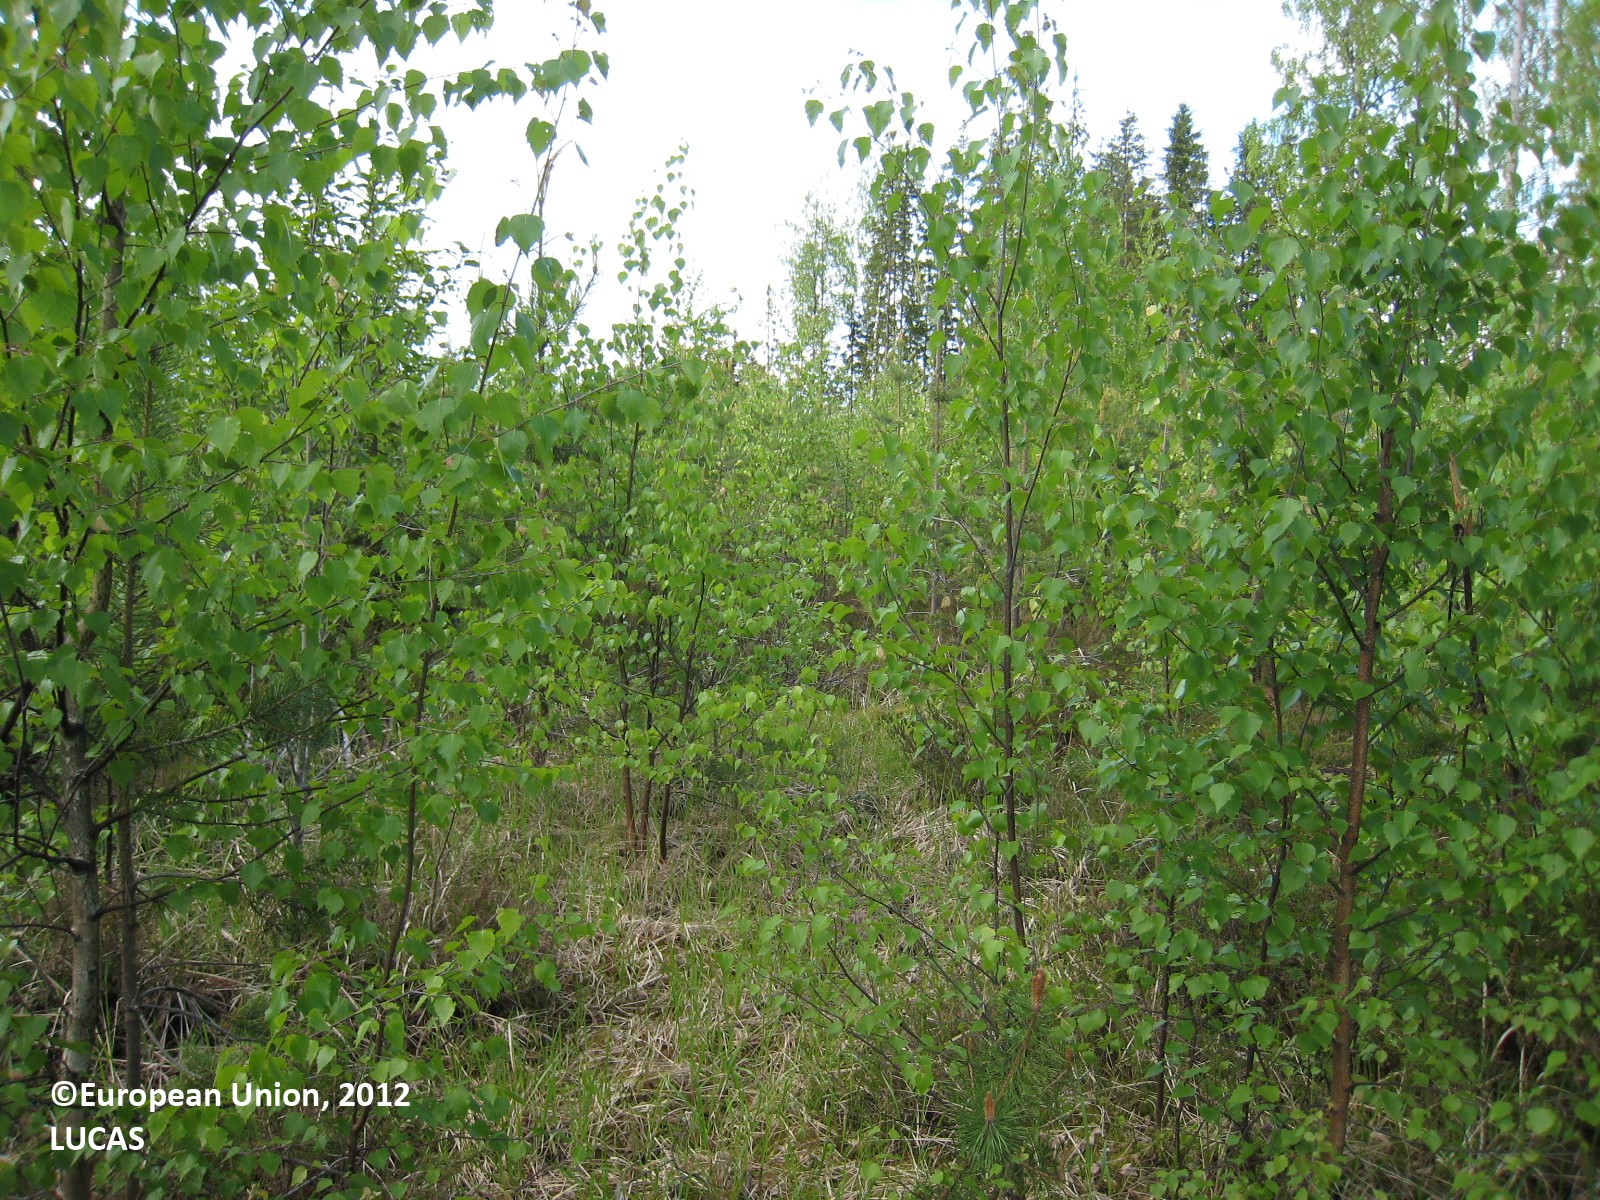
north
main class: Woodland
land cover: Pine dominated mixed woodland
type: boreal forest
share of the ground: 50 - 75 %
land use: Forestry
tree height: < 5 m
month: June
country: FI
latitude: 62.7086
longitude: 25.6550
